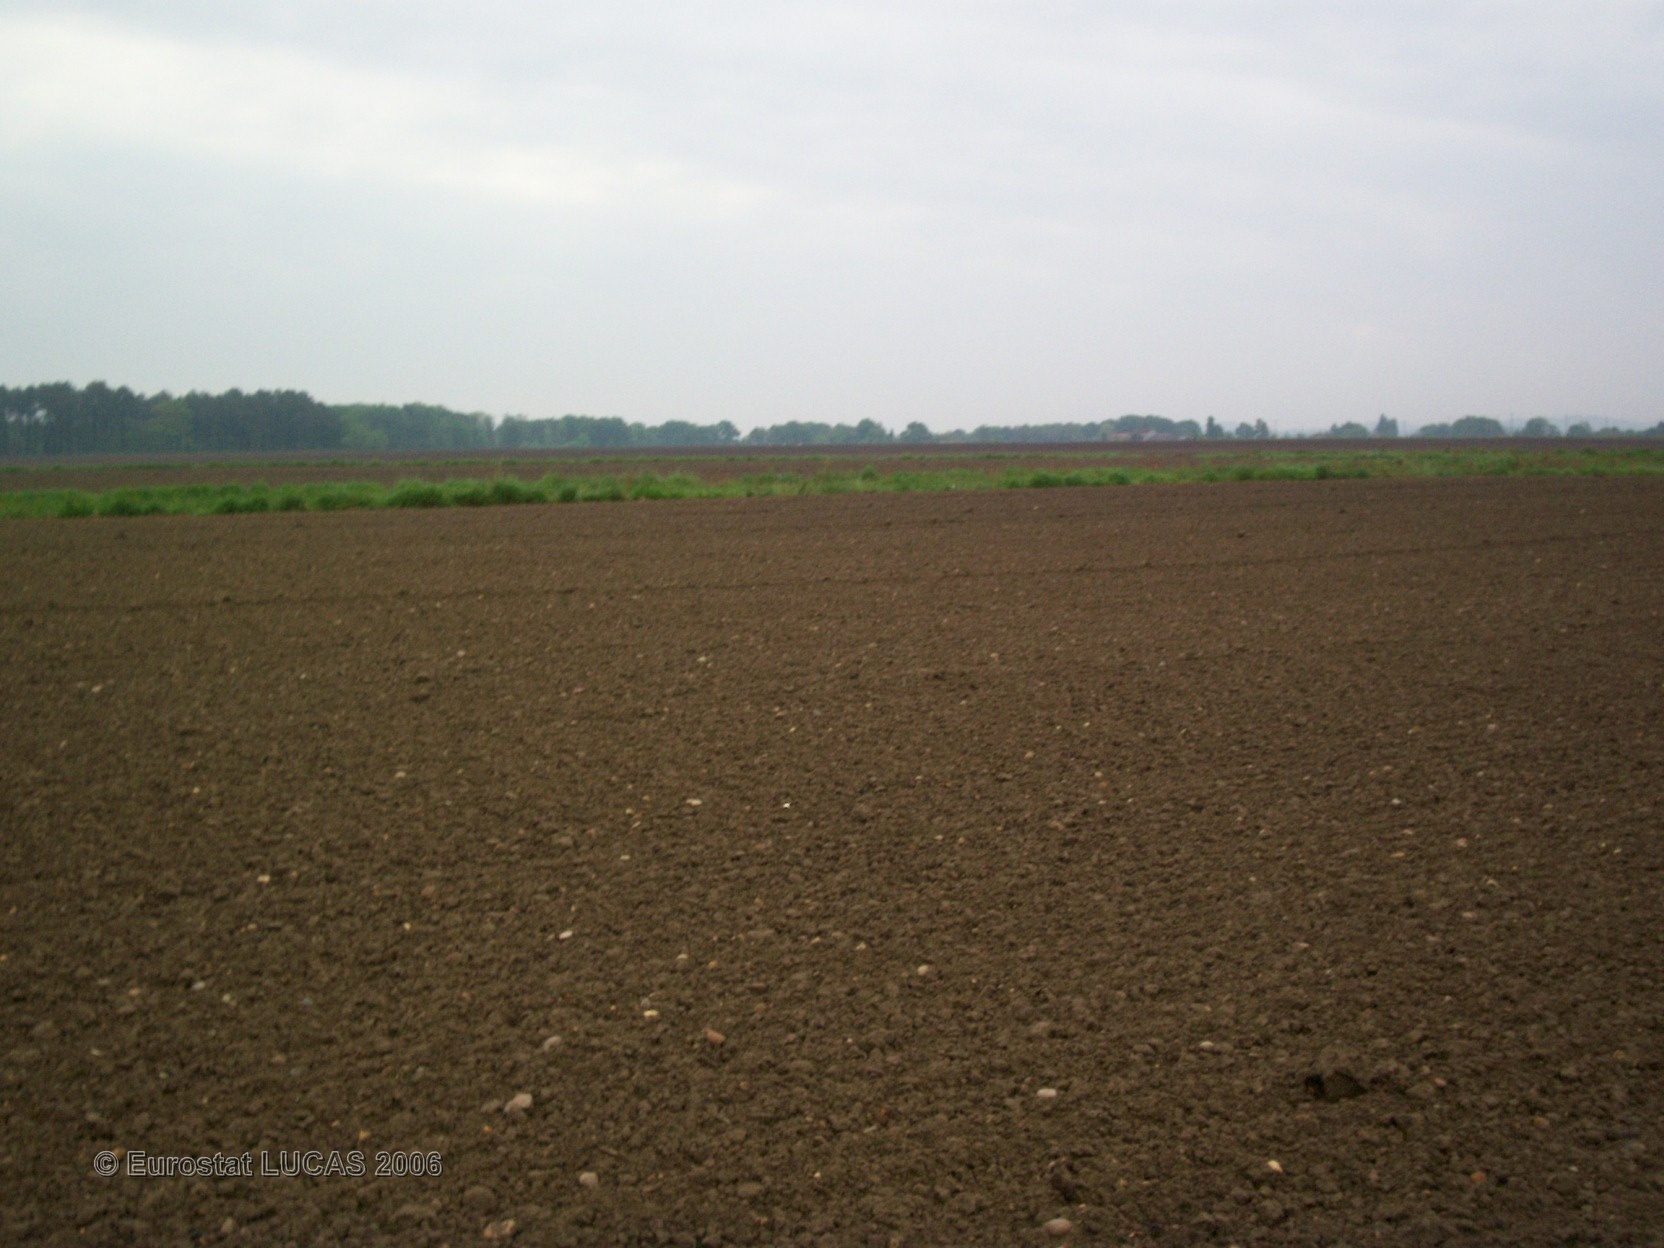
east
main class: Cropland
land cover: Maize
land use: Agriculture (excluding fallow land and kitchen gardens)
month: June
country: FR
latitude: 43.6234
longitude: -0.4318
